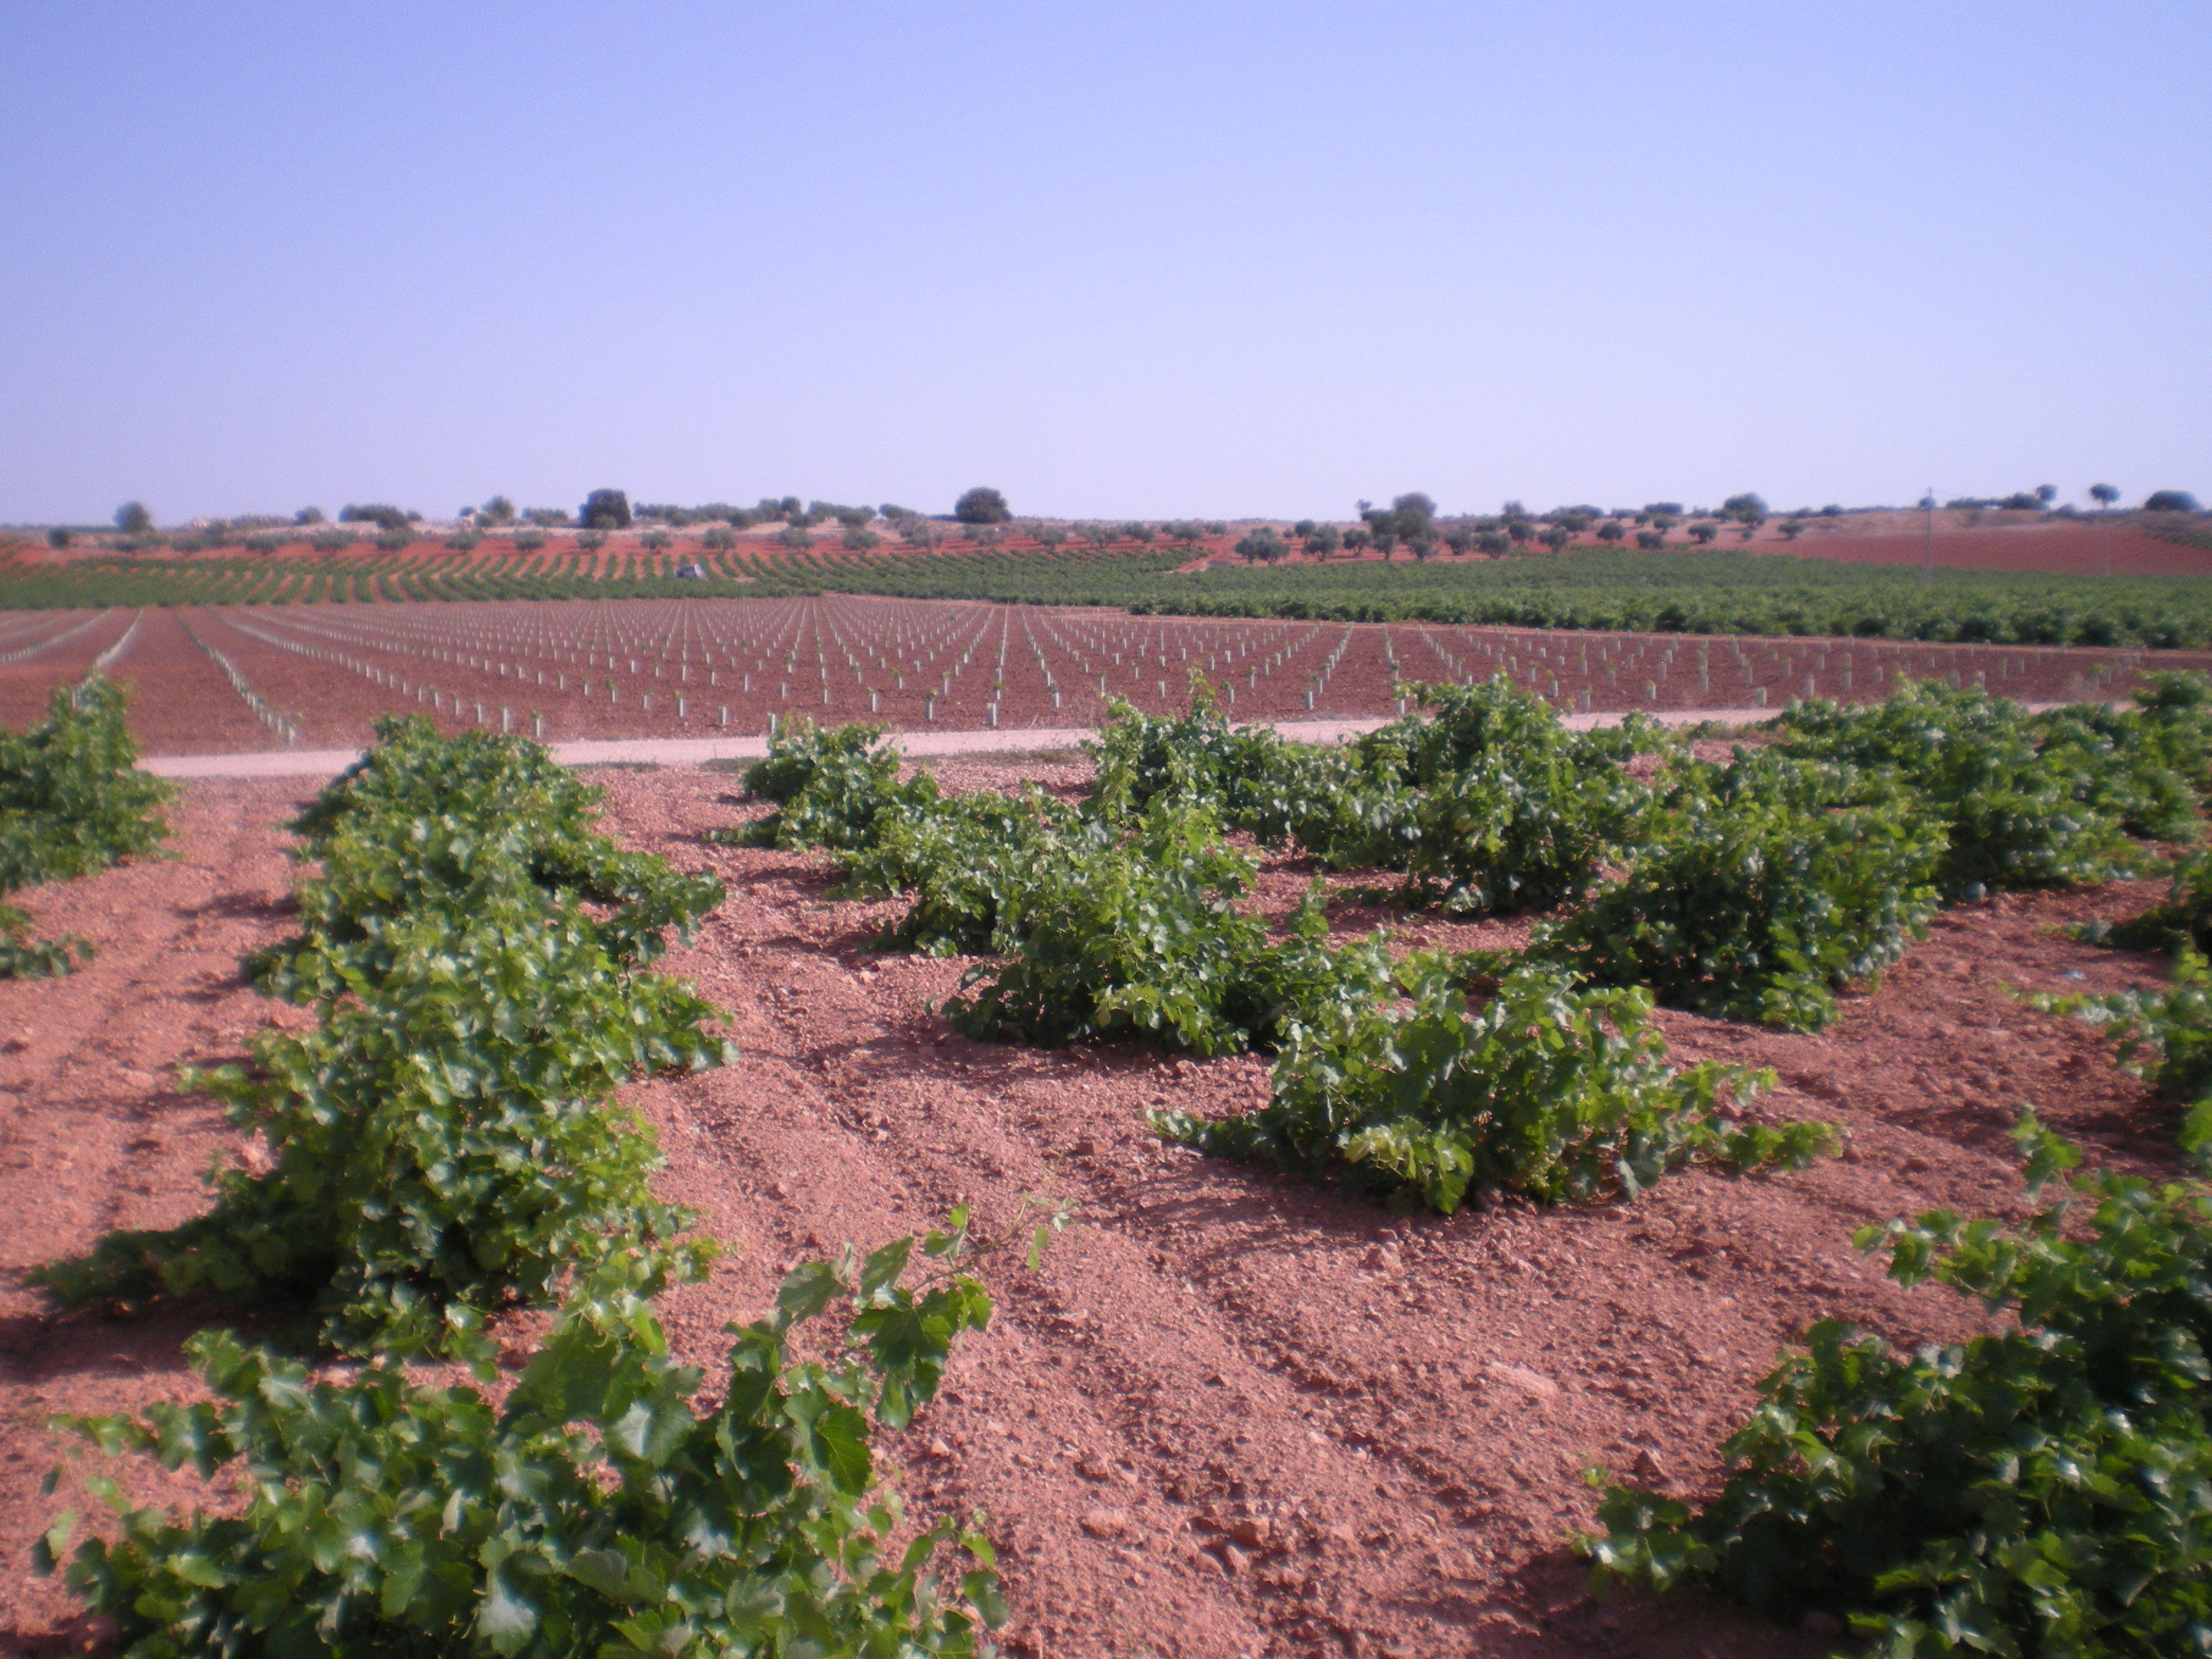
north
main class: Cropland
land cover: Vineyards
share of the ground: 10 - 25 %
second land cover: Other bare soil
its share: > 75 %
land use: Agriculture (excluding fallow land and kitchen gardens)
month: July
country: ES
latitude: 39.5063
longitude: -3.1490
